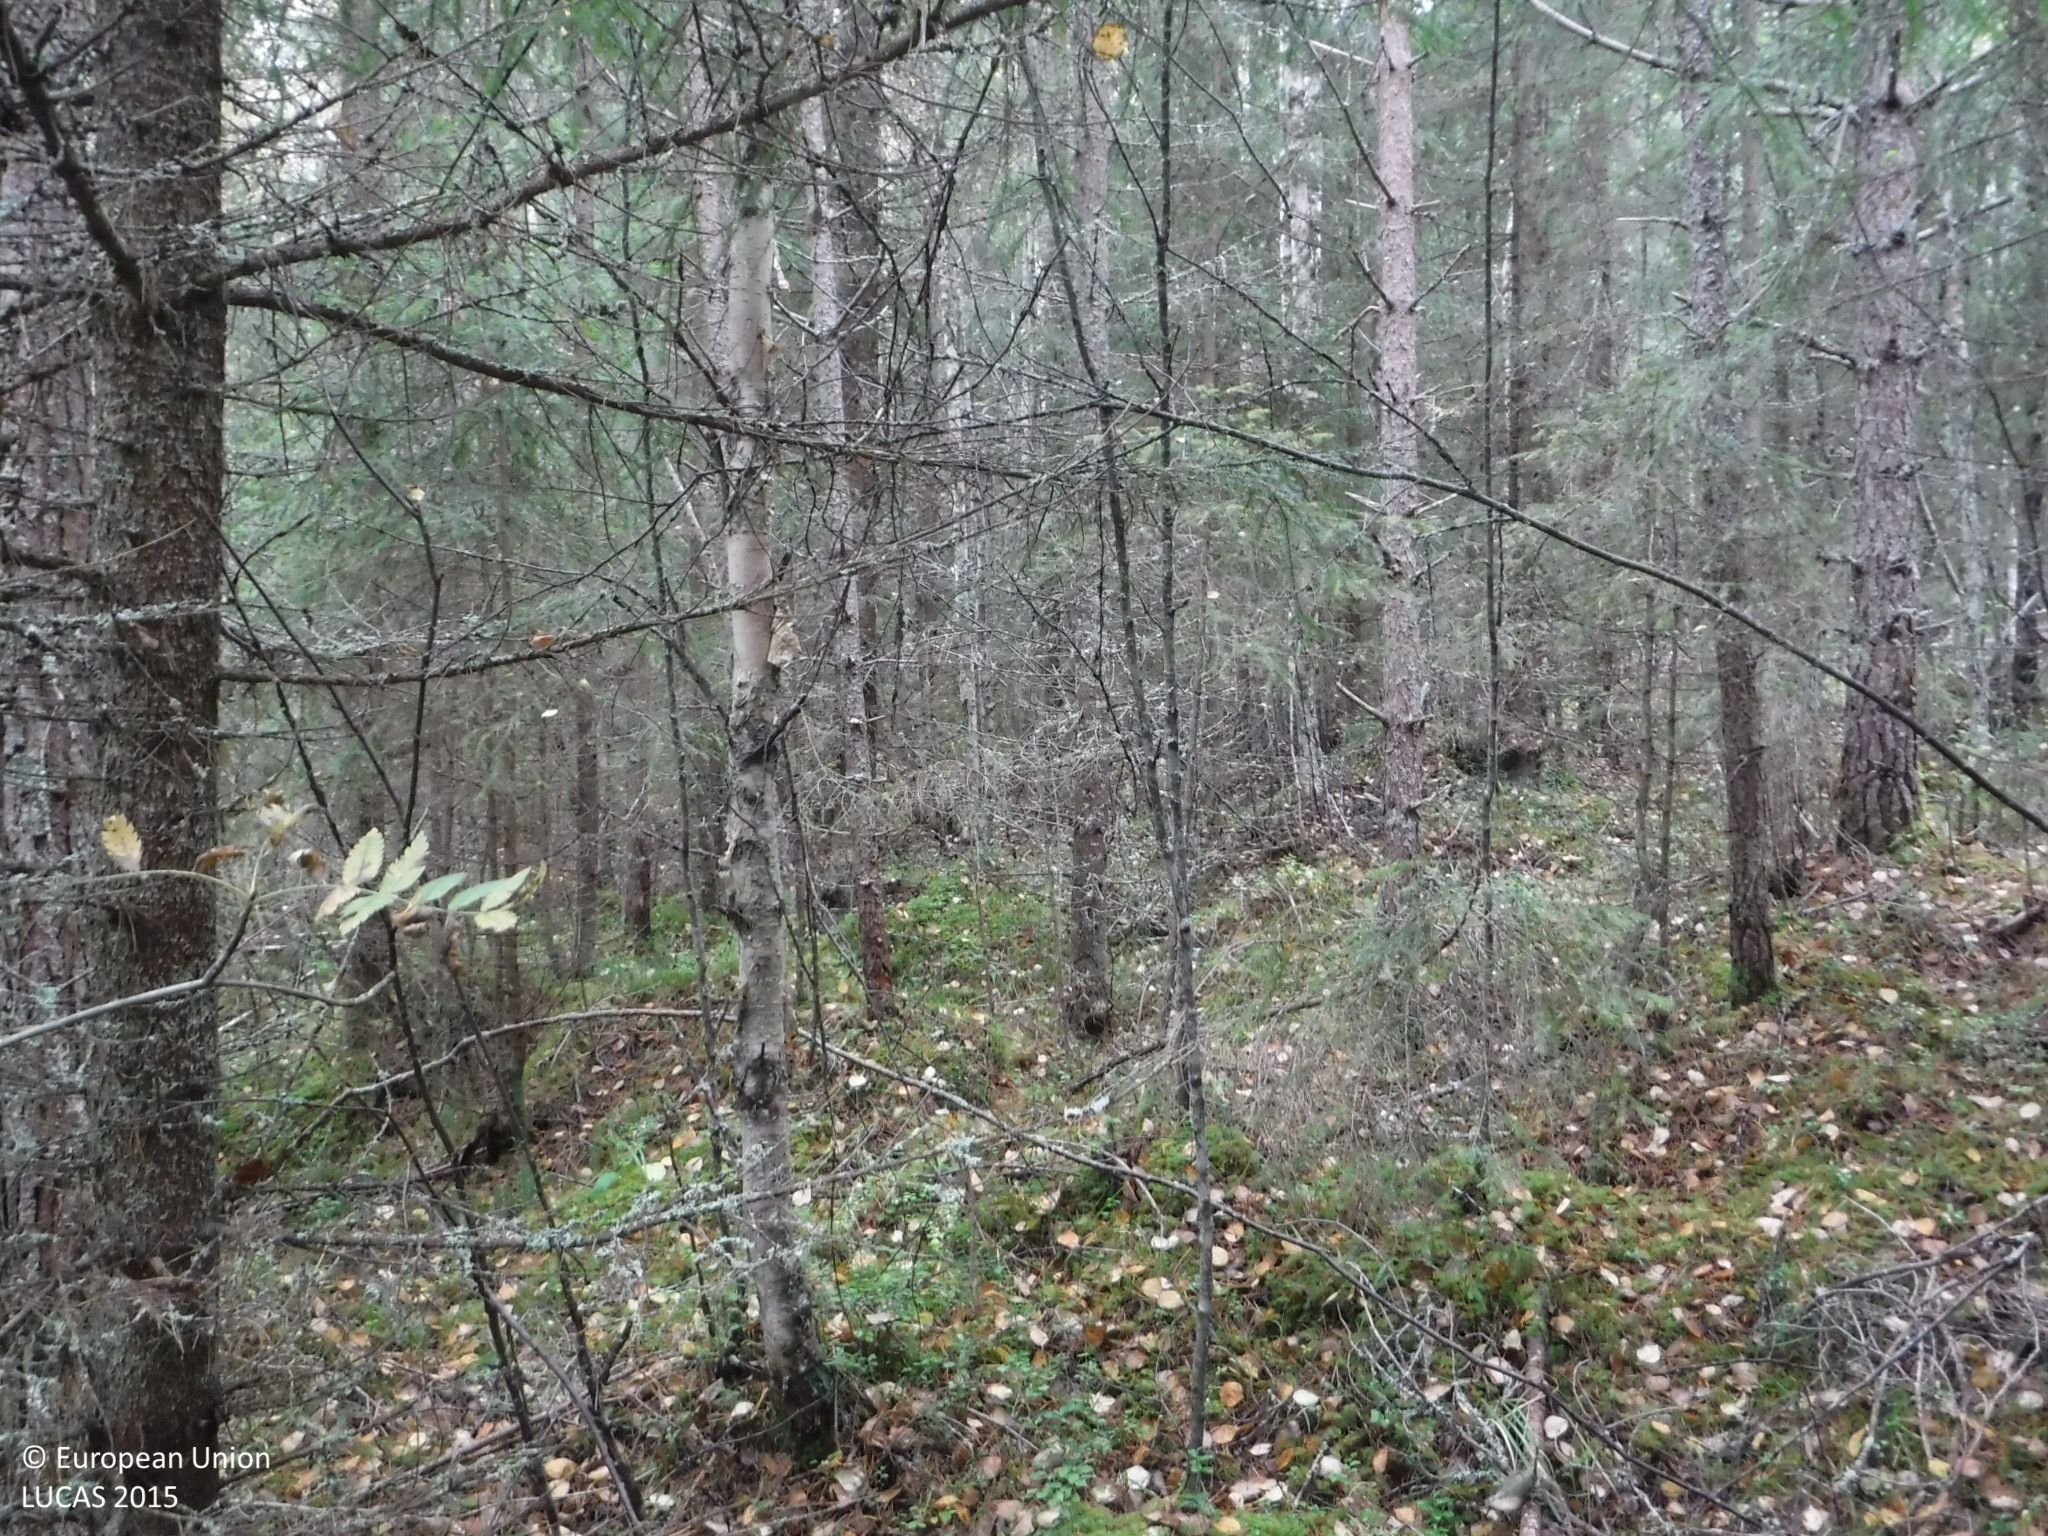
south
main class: Woodland
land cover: Other mixed woodland
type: boreal forest
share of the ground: > 75 %
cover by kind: coniferous forest trees 45 %, broadleaved forest trees 30 %, lichens and mosses 20 %, shrubs 5 %
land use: Forestry
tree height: > 5 m
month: September
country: FI
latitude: 62.0919
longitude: 23.3049
